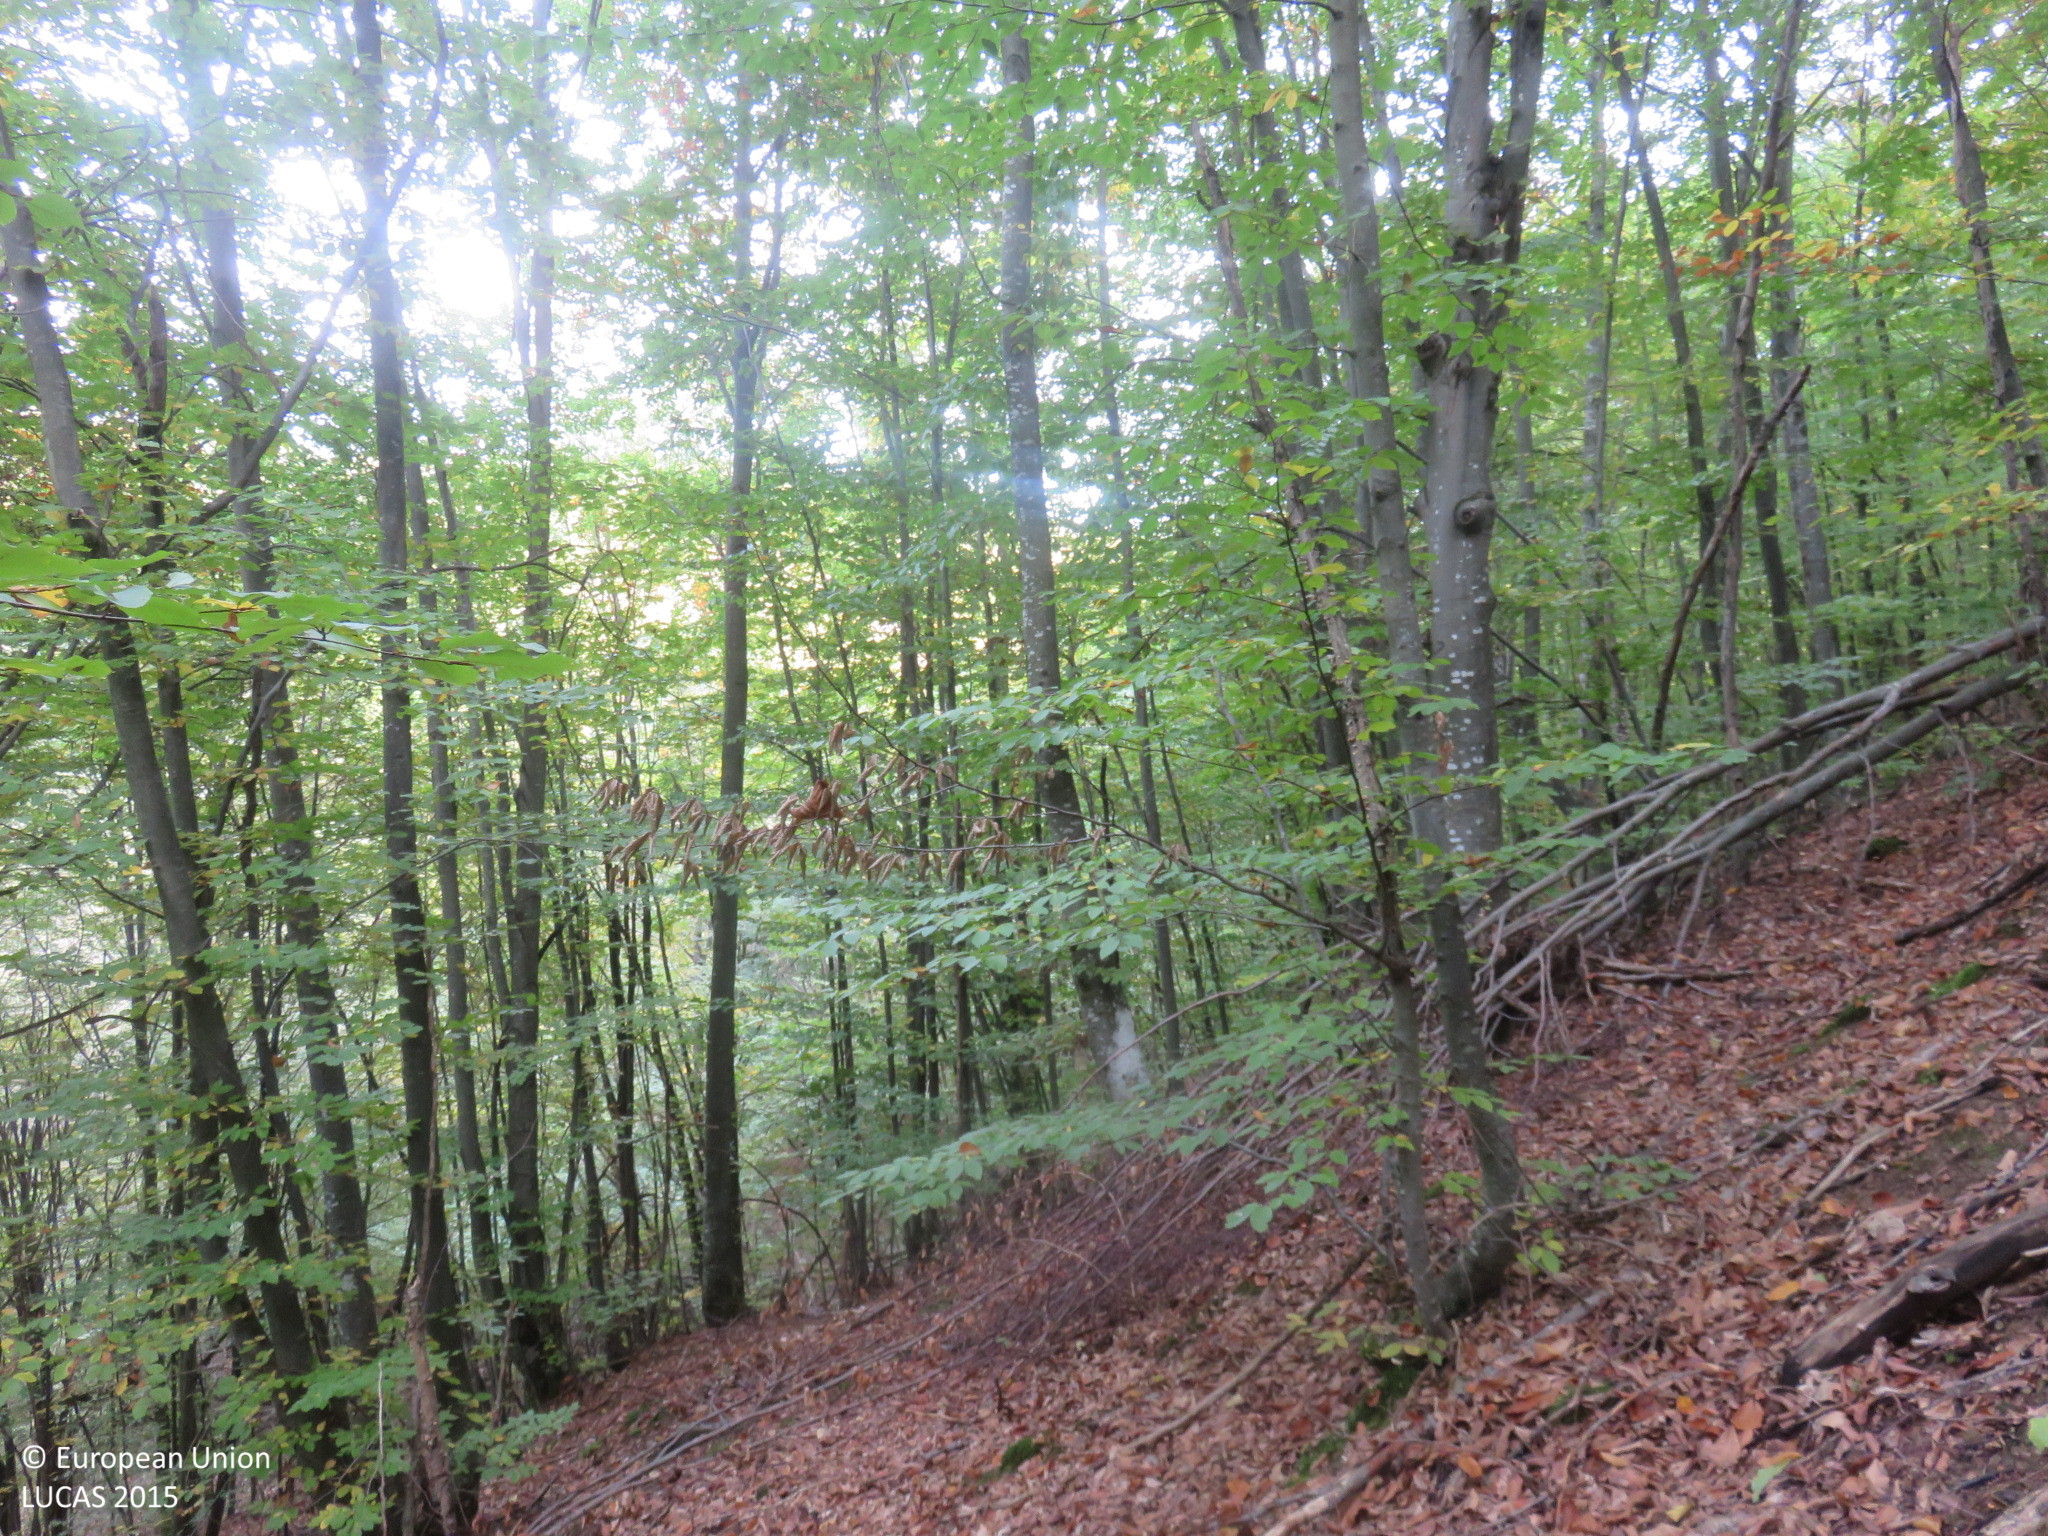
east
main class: Woodland
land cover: Broadleaved woodland
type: beech forest
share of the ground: > 75 %
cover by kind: broadleaved forest trees 85 %, unconsolidated bare surface 10 %, shrubs 5 %
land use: Forestry
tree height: > 5 m
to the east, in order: Broadleaved woodland; Rivers and streams; Broadleaved woodland; Grassland with sparse tree/shrub cover; Broadleaved woodland; Spruce dominated mixed woodland
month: October
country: BG
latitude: 42.9090
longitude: 24.9709
